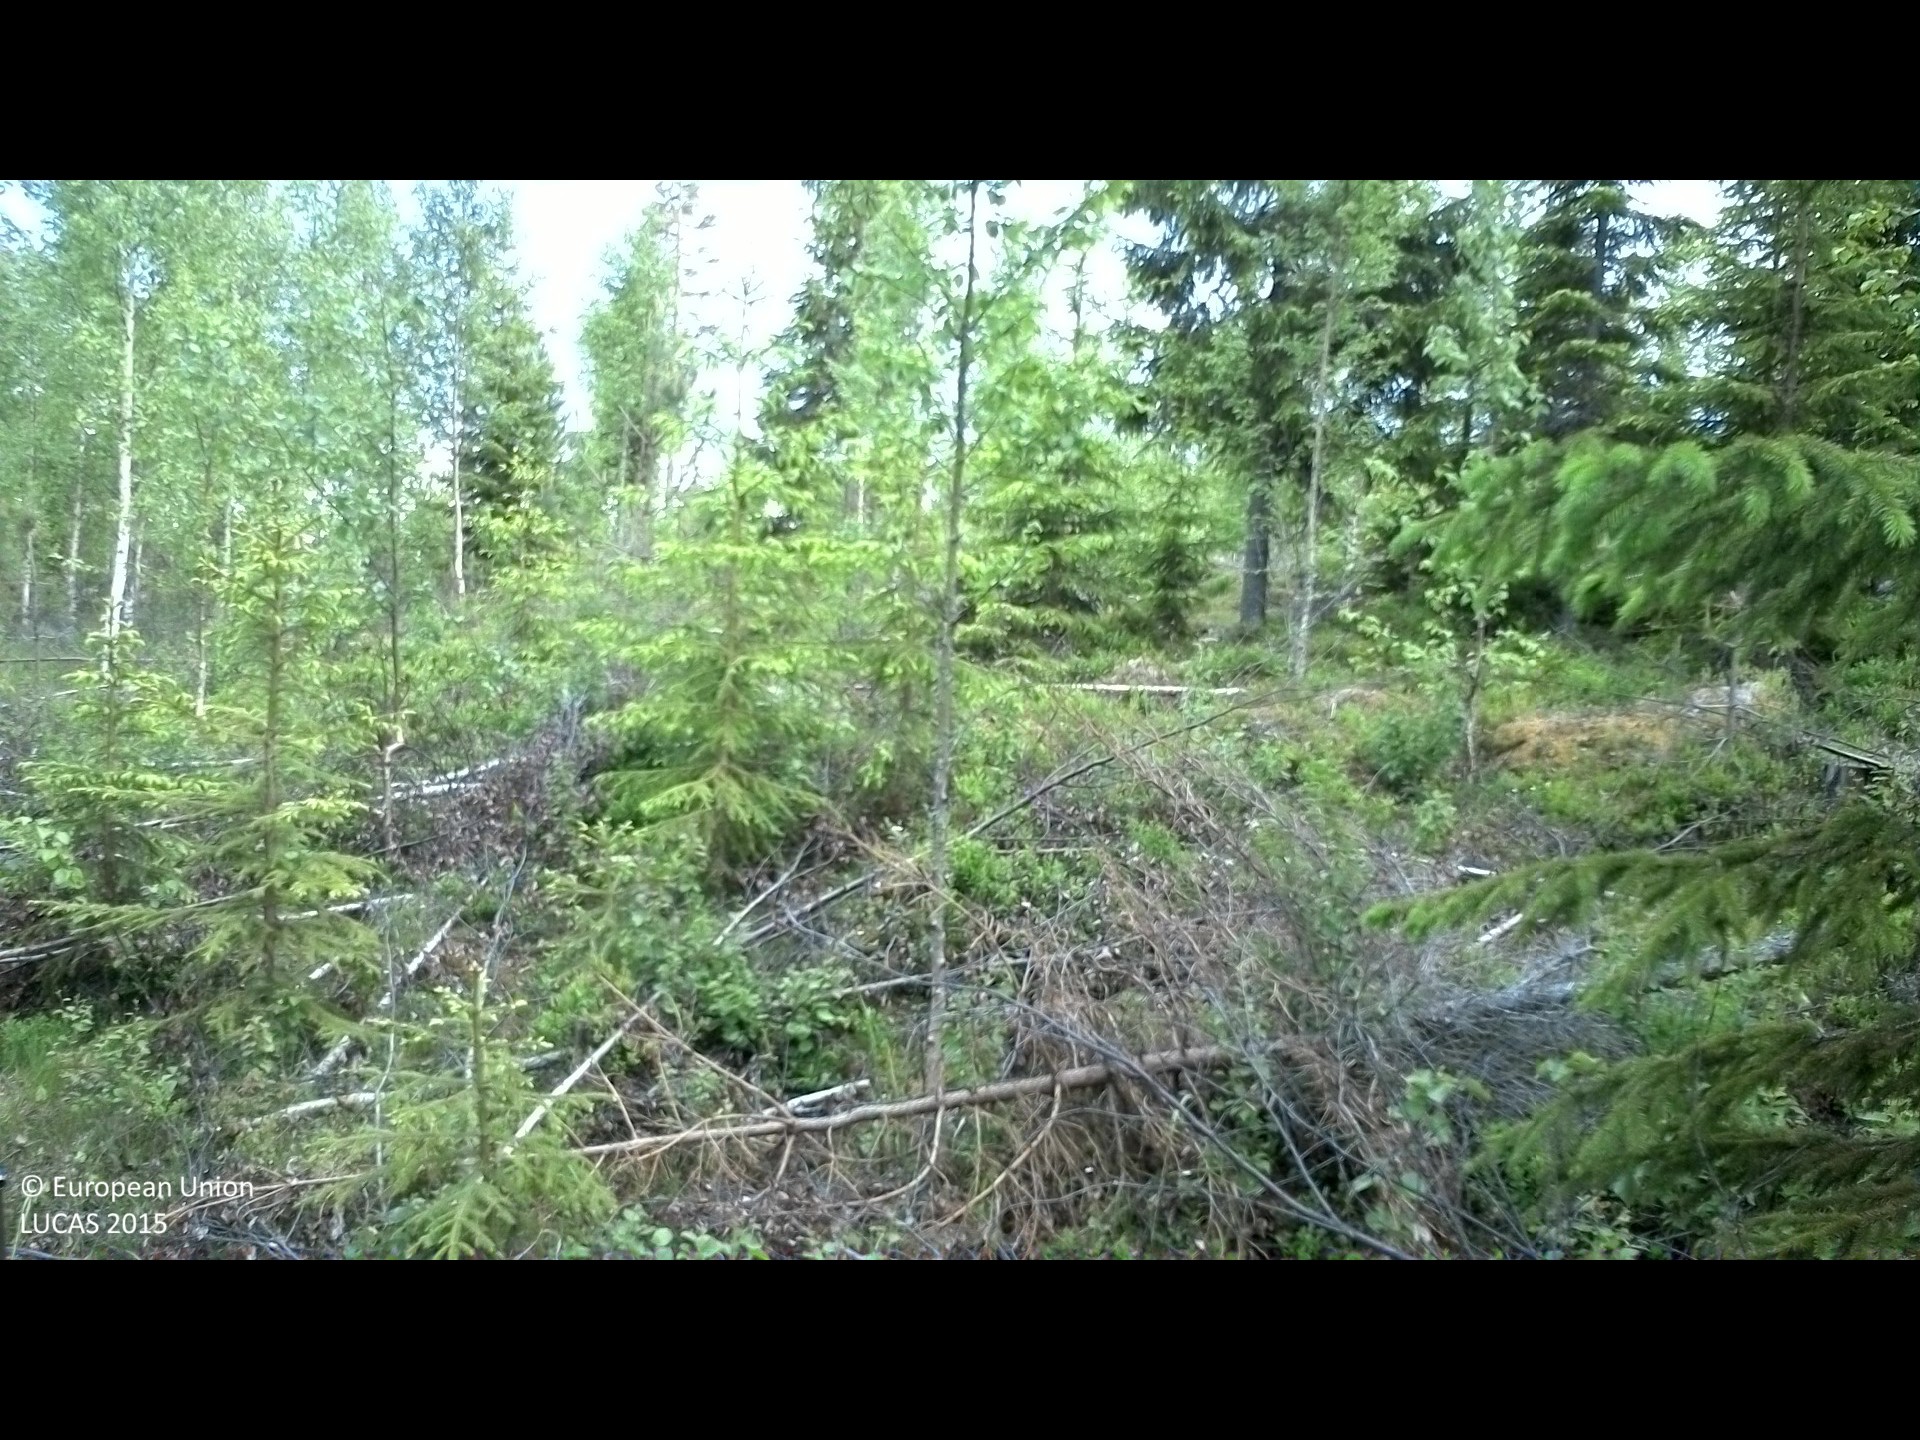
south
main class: Woodland
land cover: Spruce dominated mixed woodland
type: boreal forest
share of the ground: 25 - 50 %
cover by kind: lichens and mosses 40 %, shrubs 25 %, coniferous forest trees 15 %, broadleaved forest trees 10 %, herbaceous plants 10 %
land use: Forestry
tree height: > 5 m
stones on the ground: < 10 %
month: June
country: SE
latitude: 62.2051
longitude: 17.1900
